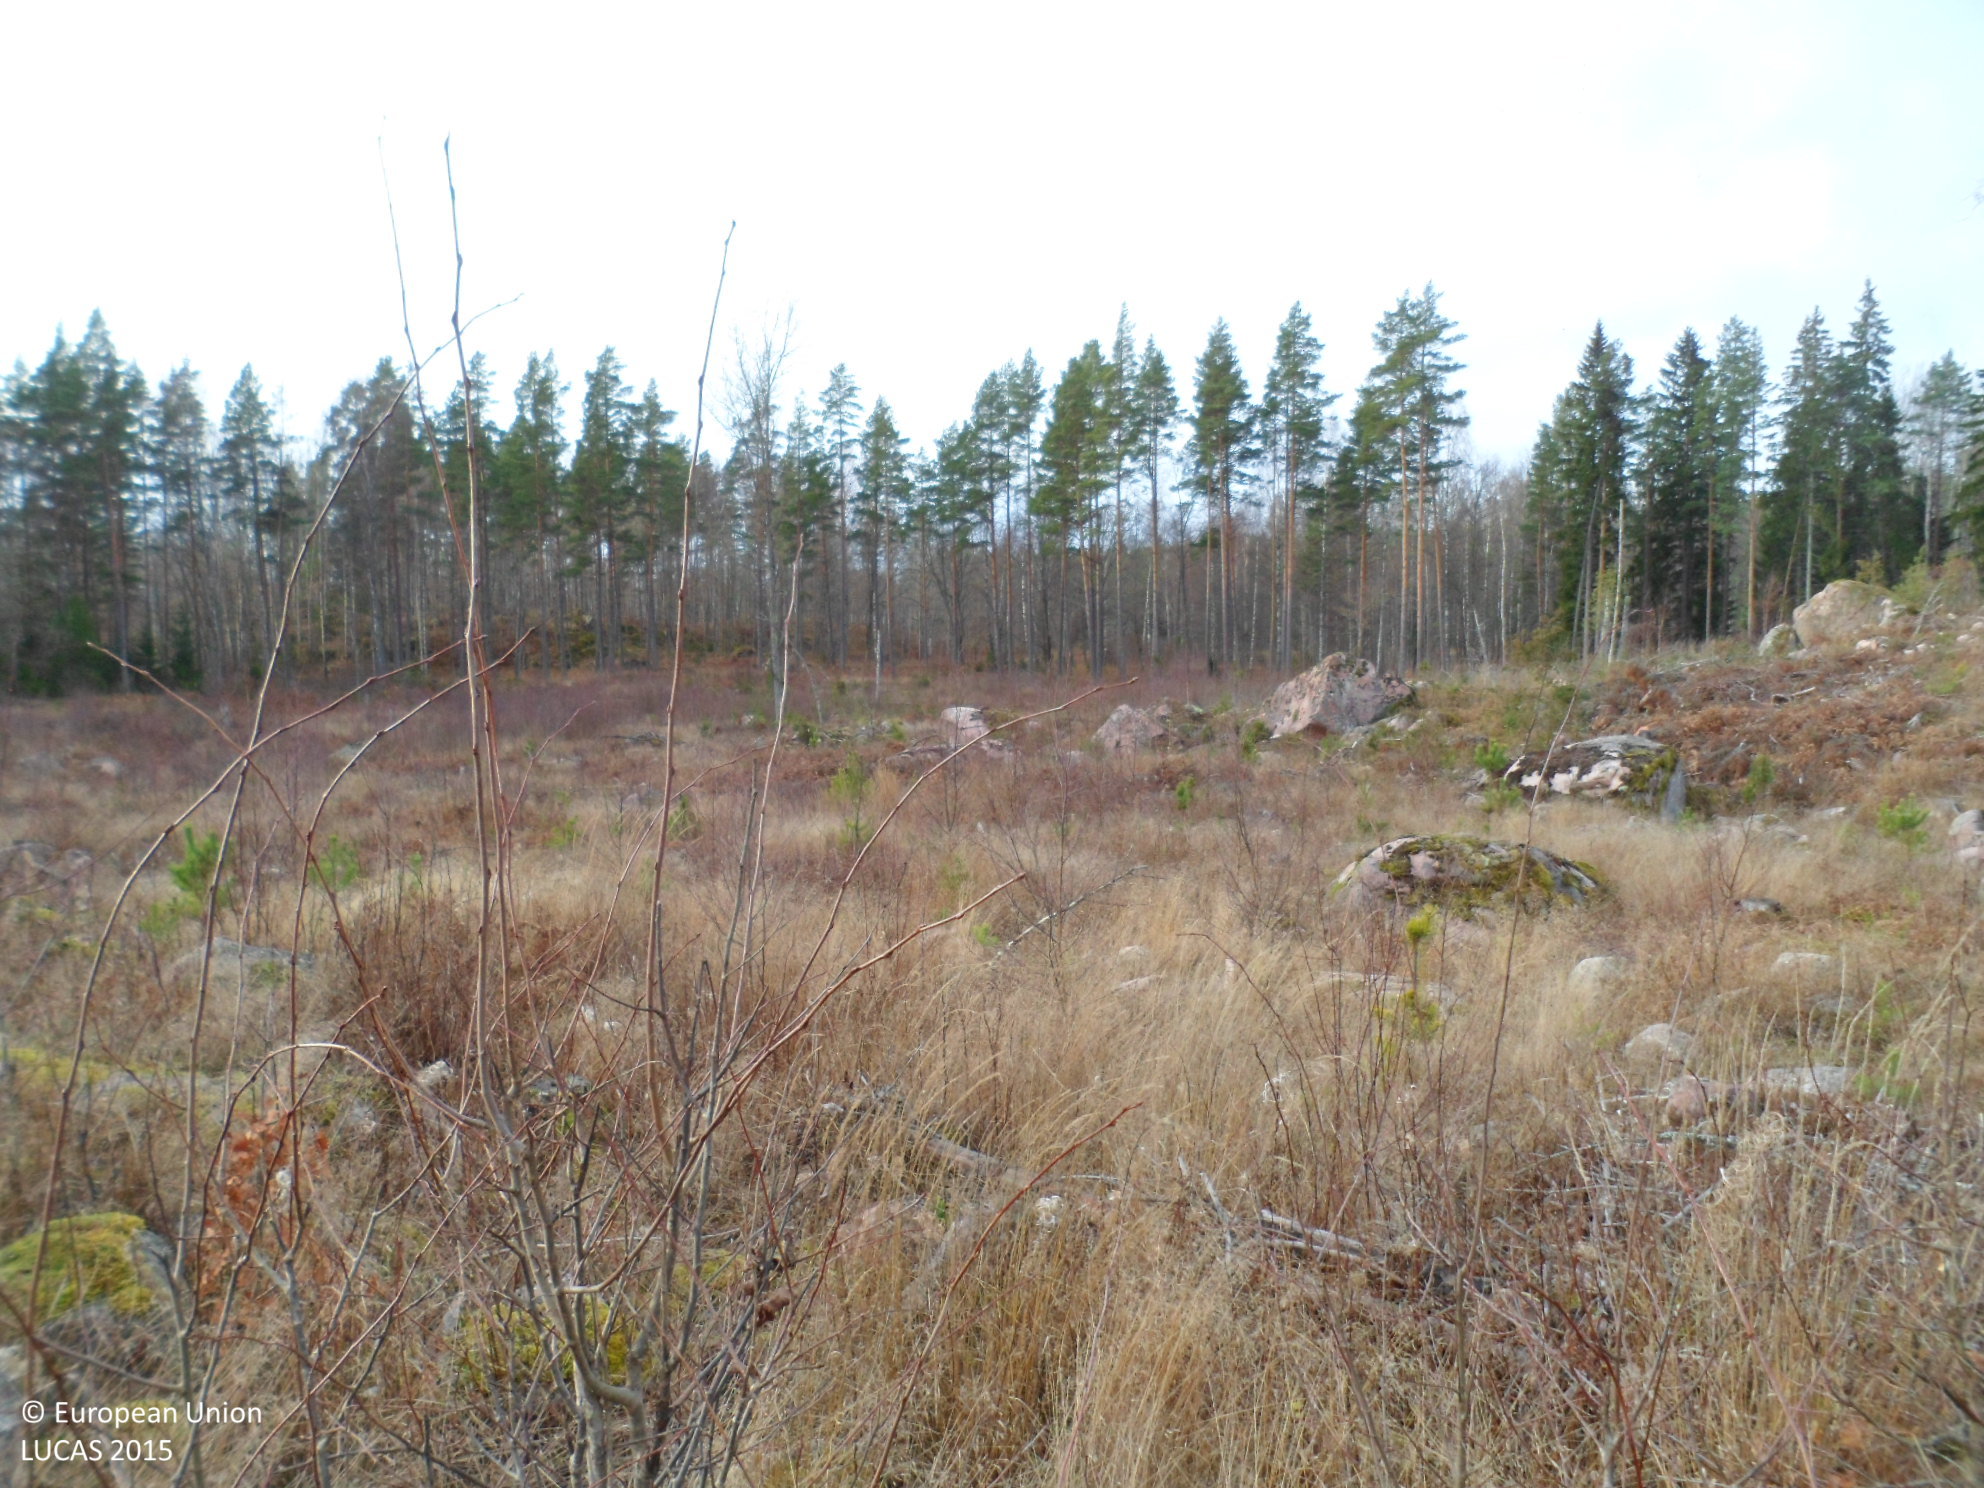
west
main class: Woodland
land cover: Broadleaved woodland
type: boreal forest
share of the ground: 10 - 25 %
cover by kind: herbaceous plants 35 %, broadleaved forest trees 20 %, shrubs 20 %, lichens and mosses 10 %, unconsolidated bare surface 10 %, coniferous forest trees 5 %
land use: Forestry
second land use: Amenities, museums, leisure
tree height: < 5 m
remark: Clear cut
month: November
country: SE
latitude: 57.2073
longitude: 15.8752
